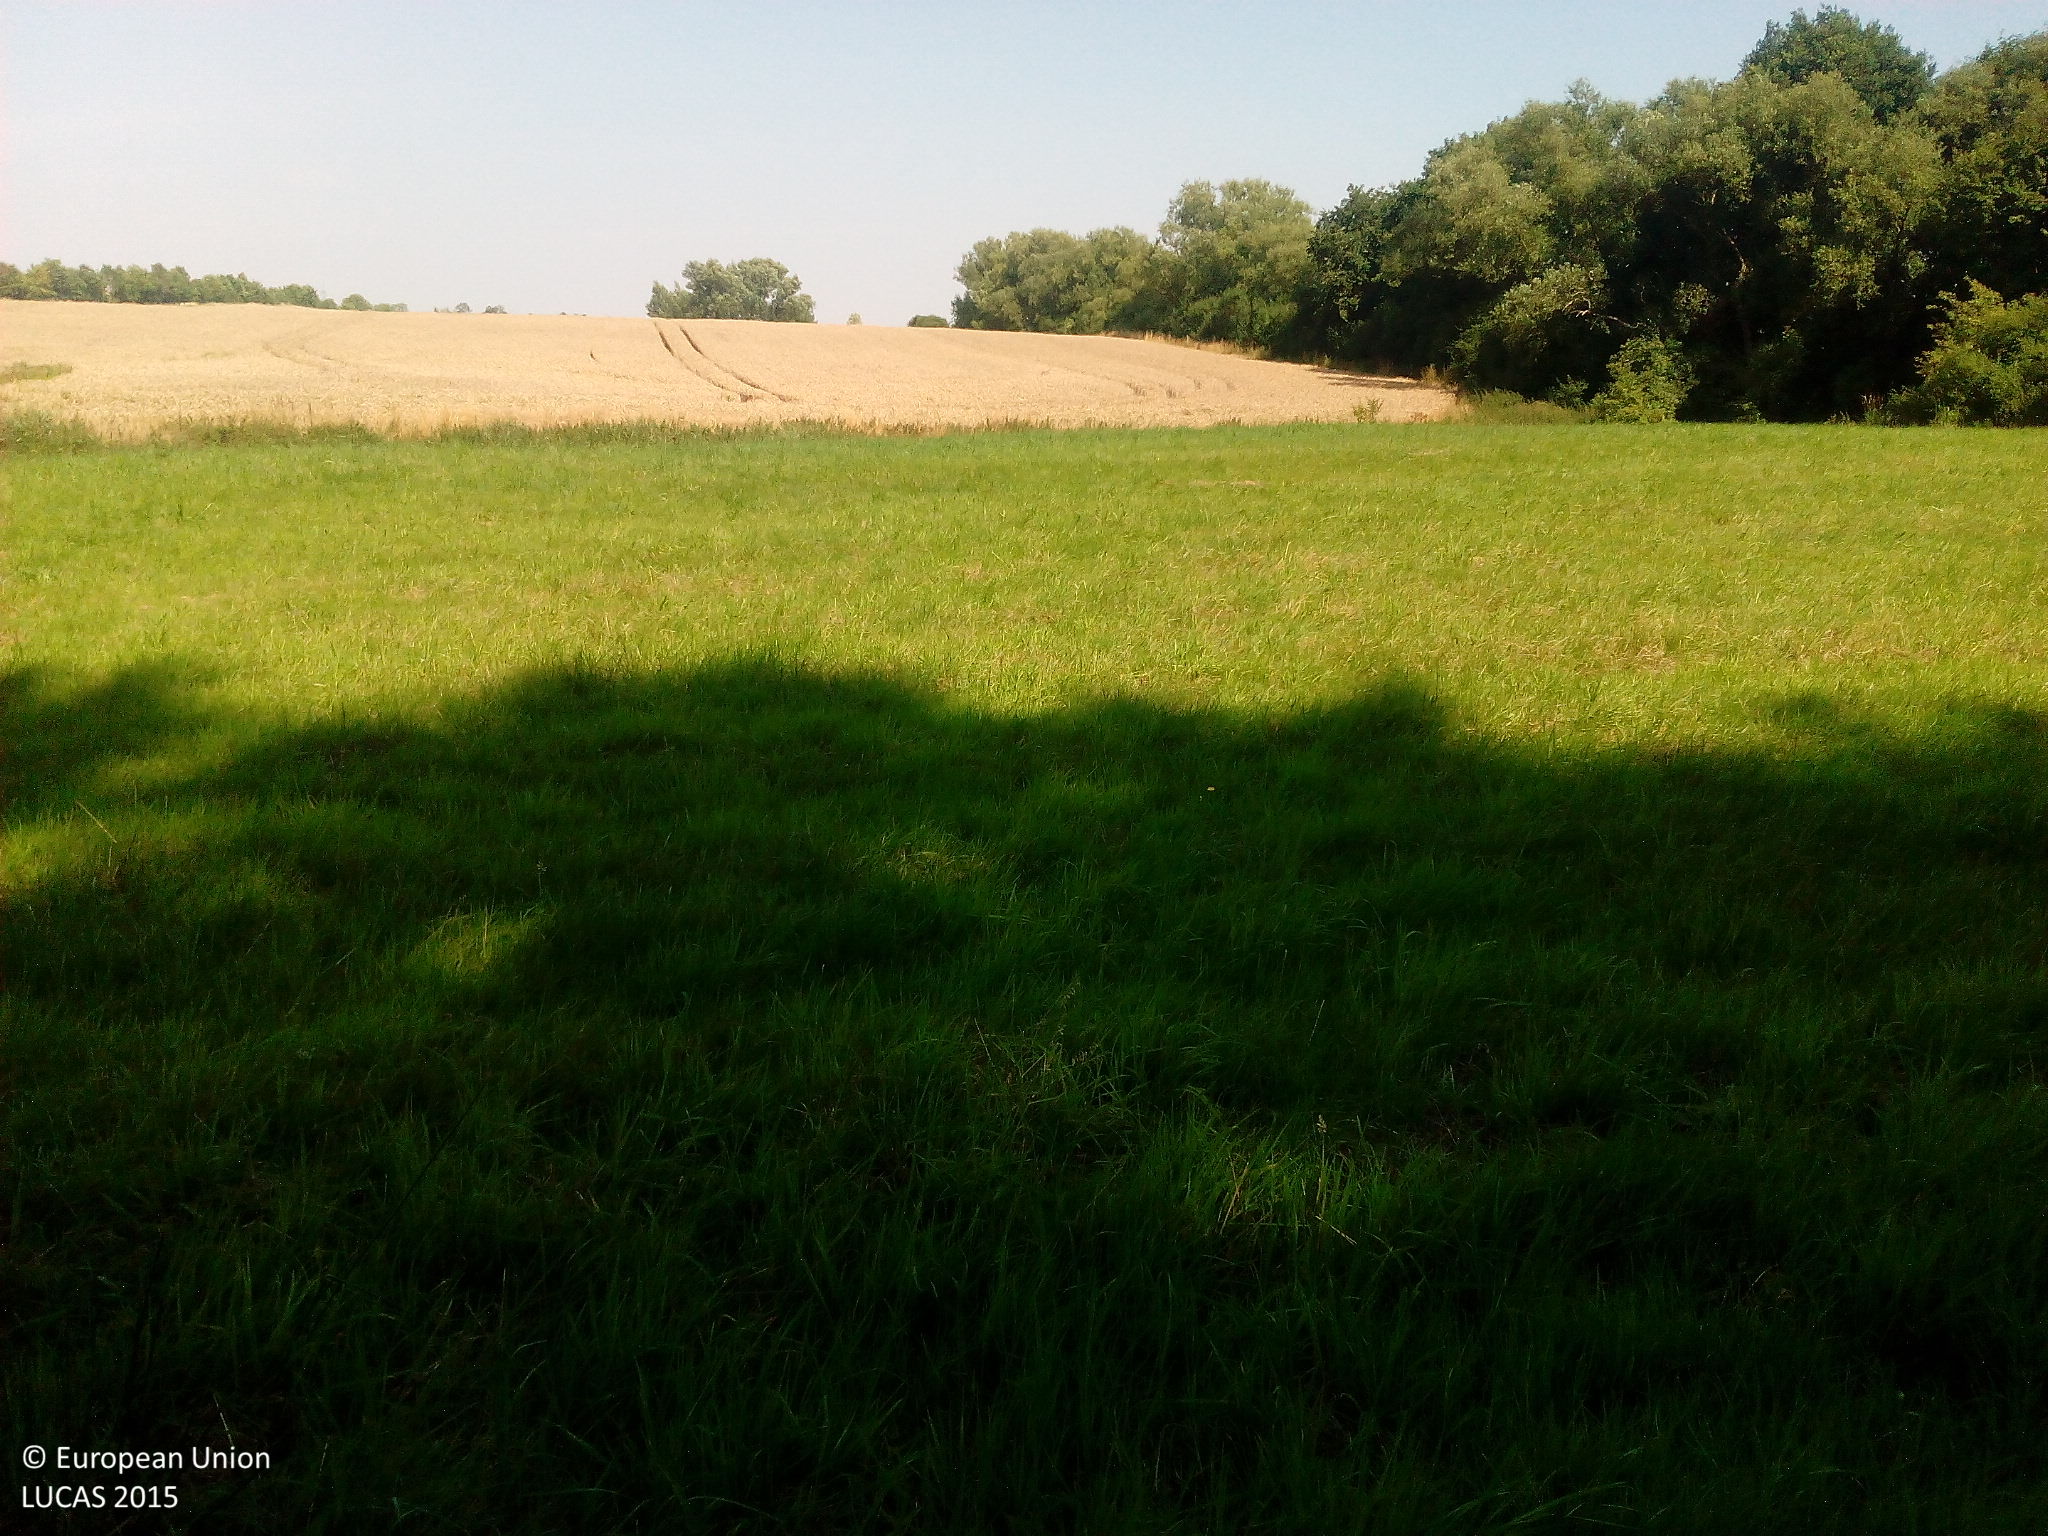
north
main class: Grassland
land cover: Grassland without tree/shrub cover
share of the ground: > 75 %
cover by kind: herbaceous plants 100 %
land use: Agriculture (excluding fallow land and kitchen gardens)
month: August
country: DE
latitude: 53.6062
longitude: 12.6744
